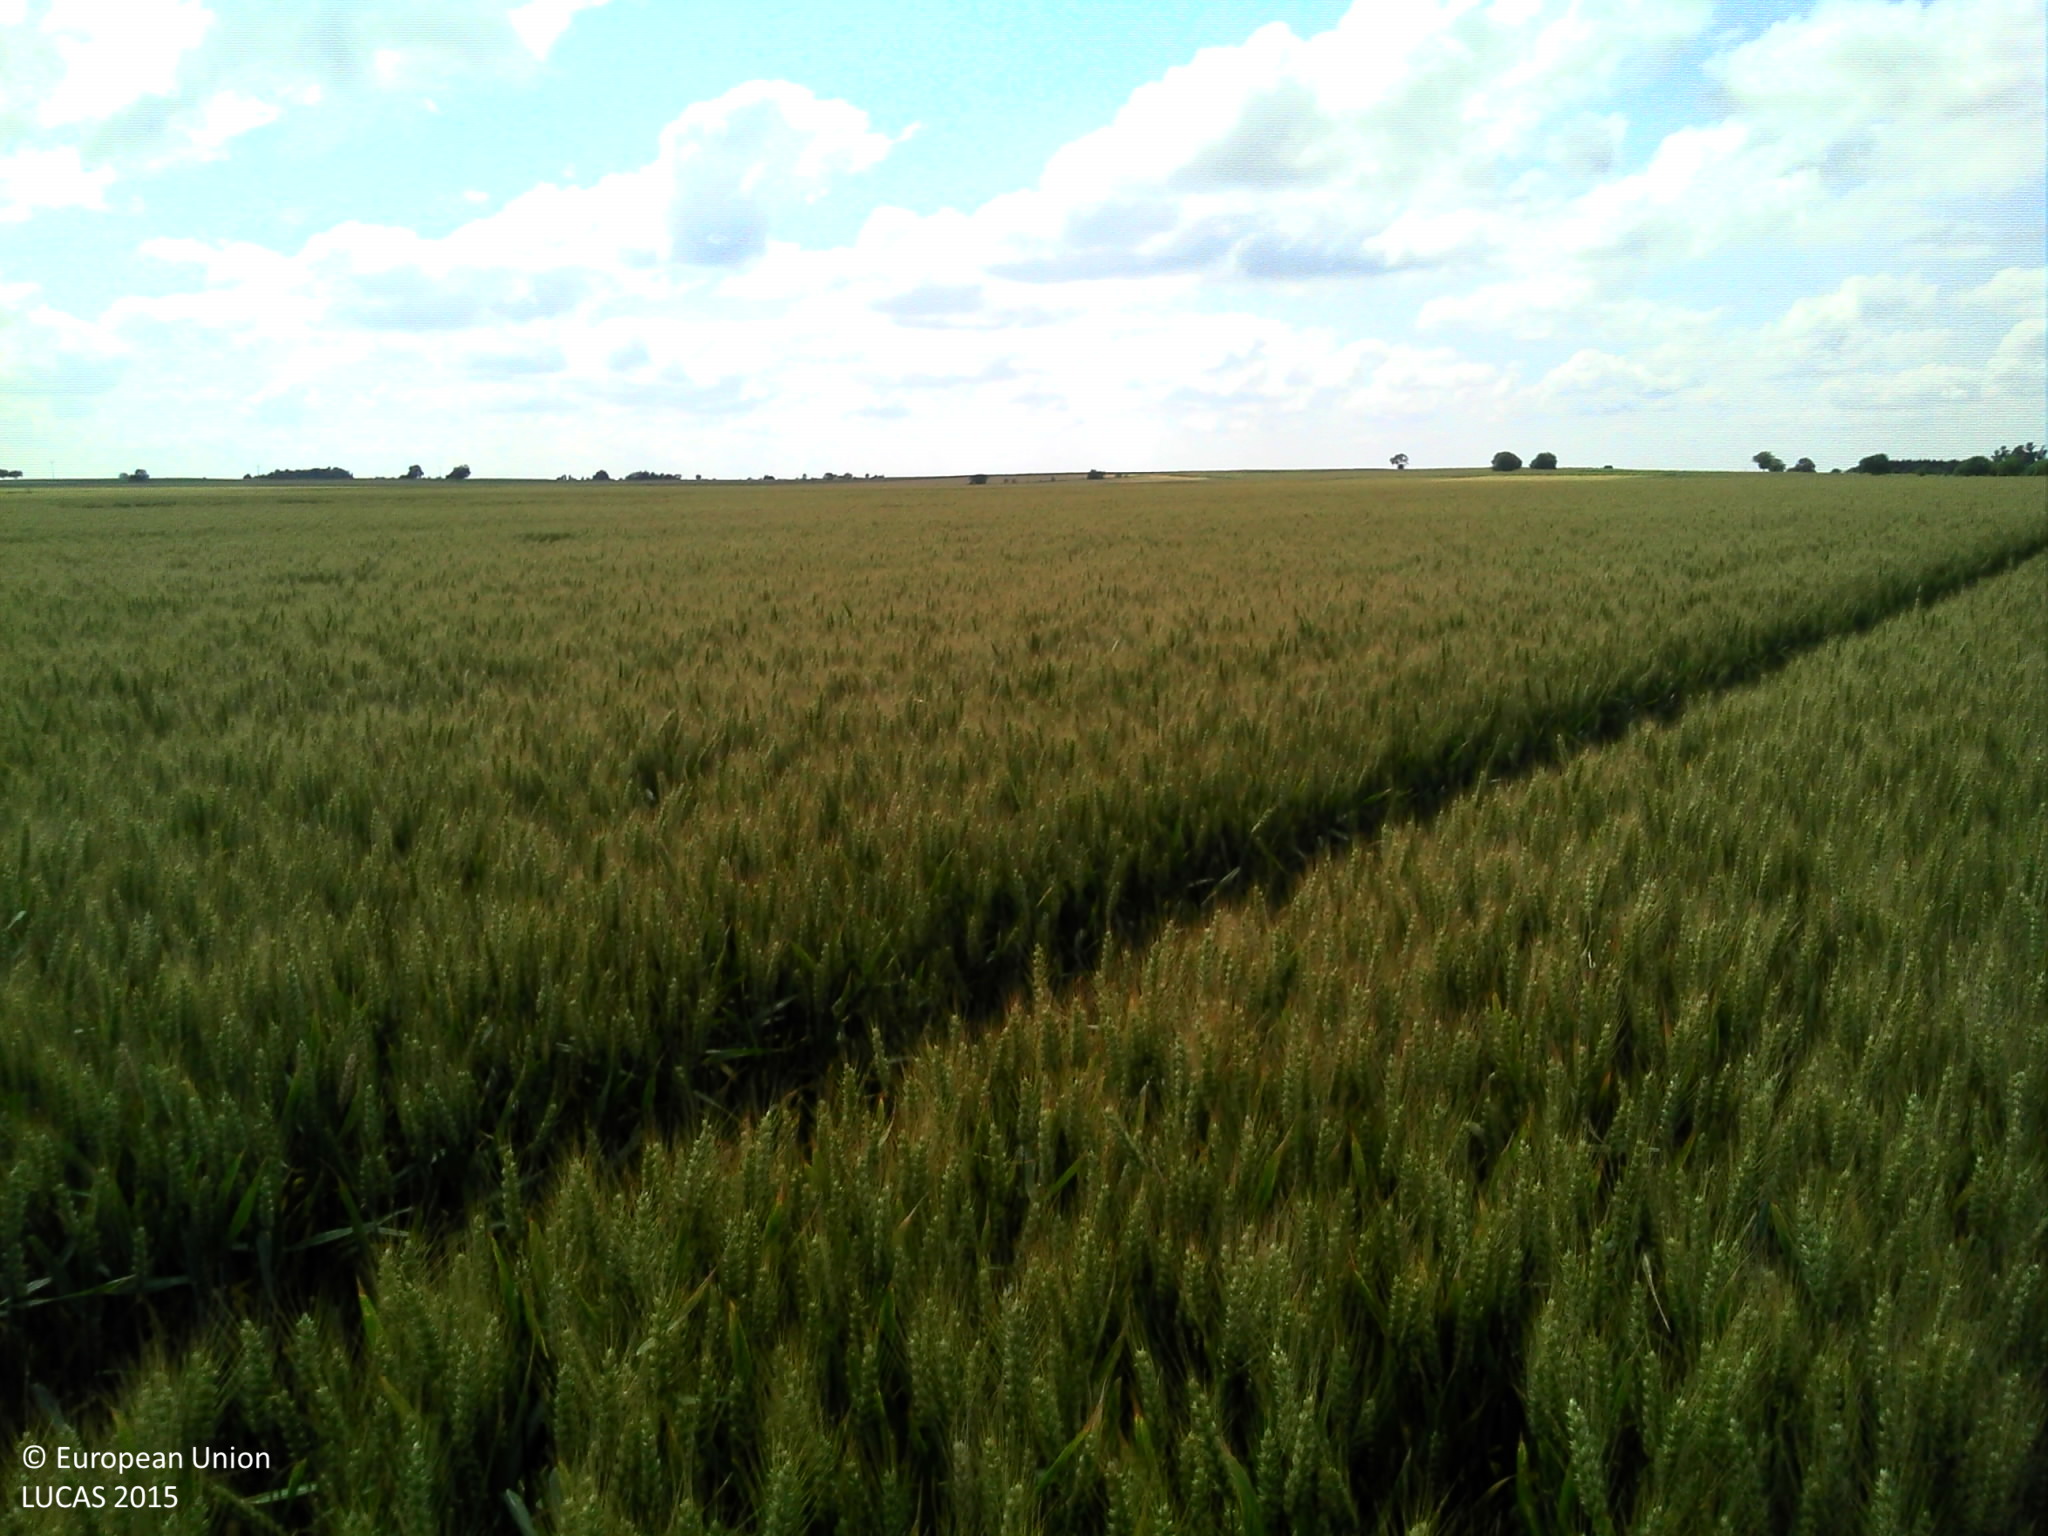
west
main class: Cropland
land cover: Common wheat
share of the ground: > 75 %
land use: Agriculture (excluding fallow land and kitchen gardens)
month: June
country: FR
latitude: 46.6681
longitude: 0.2685
